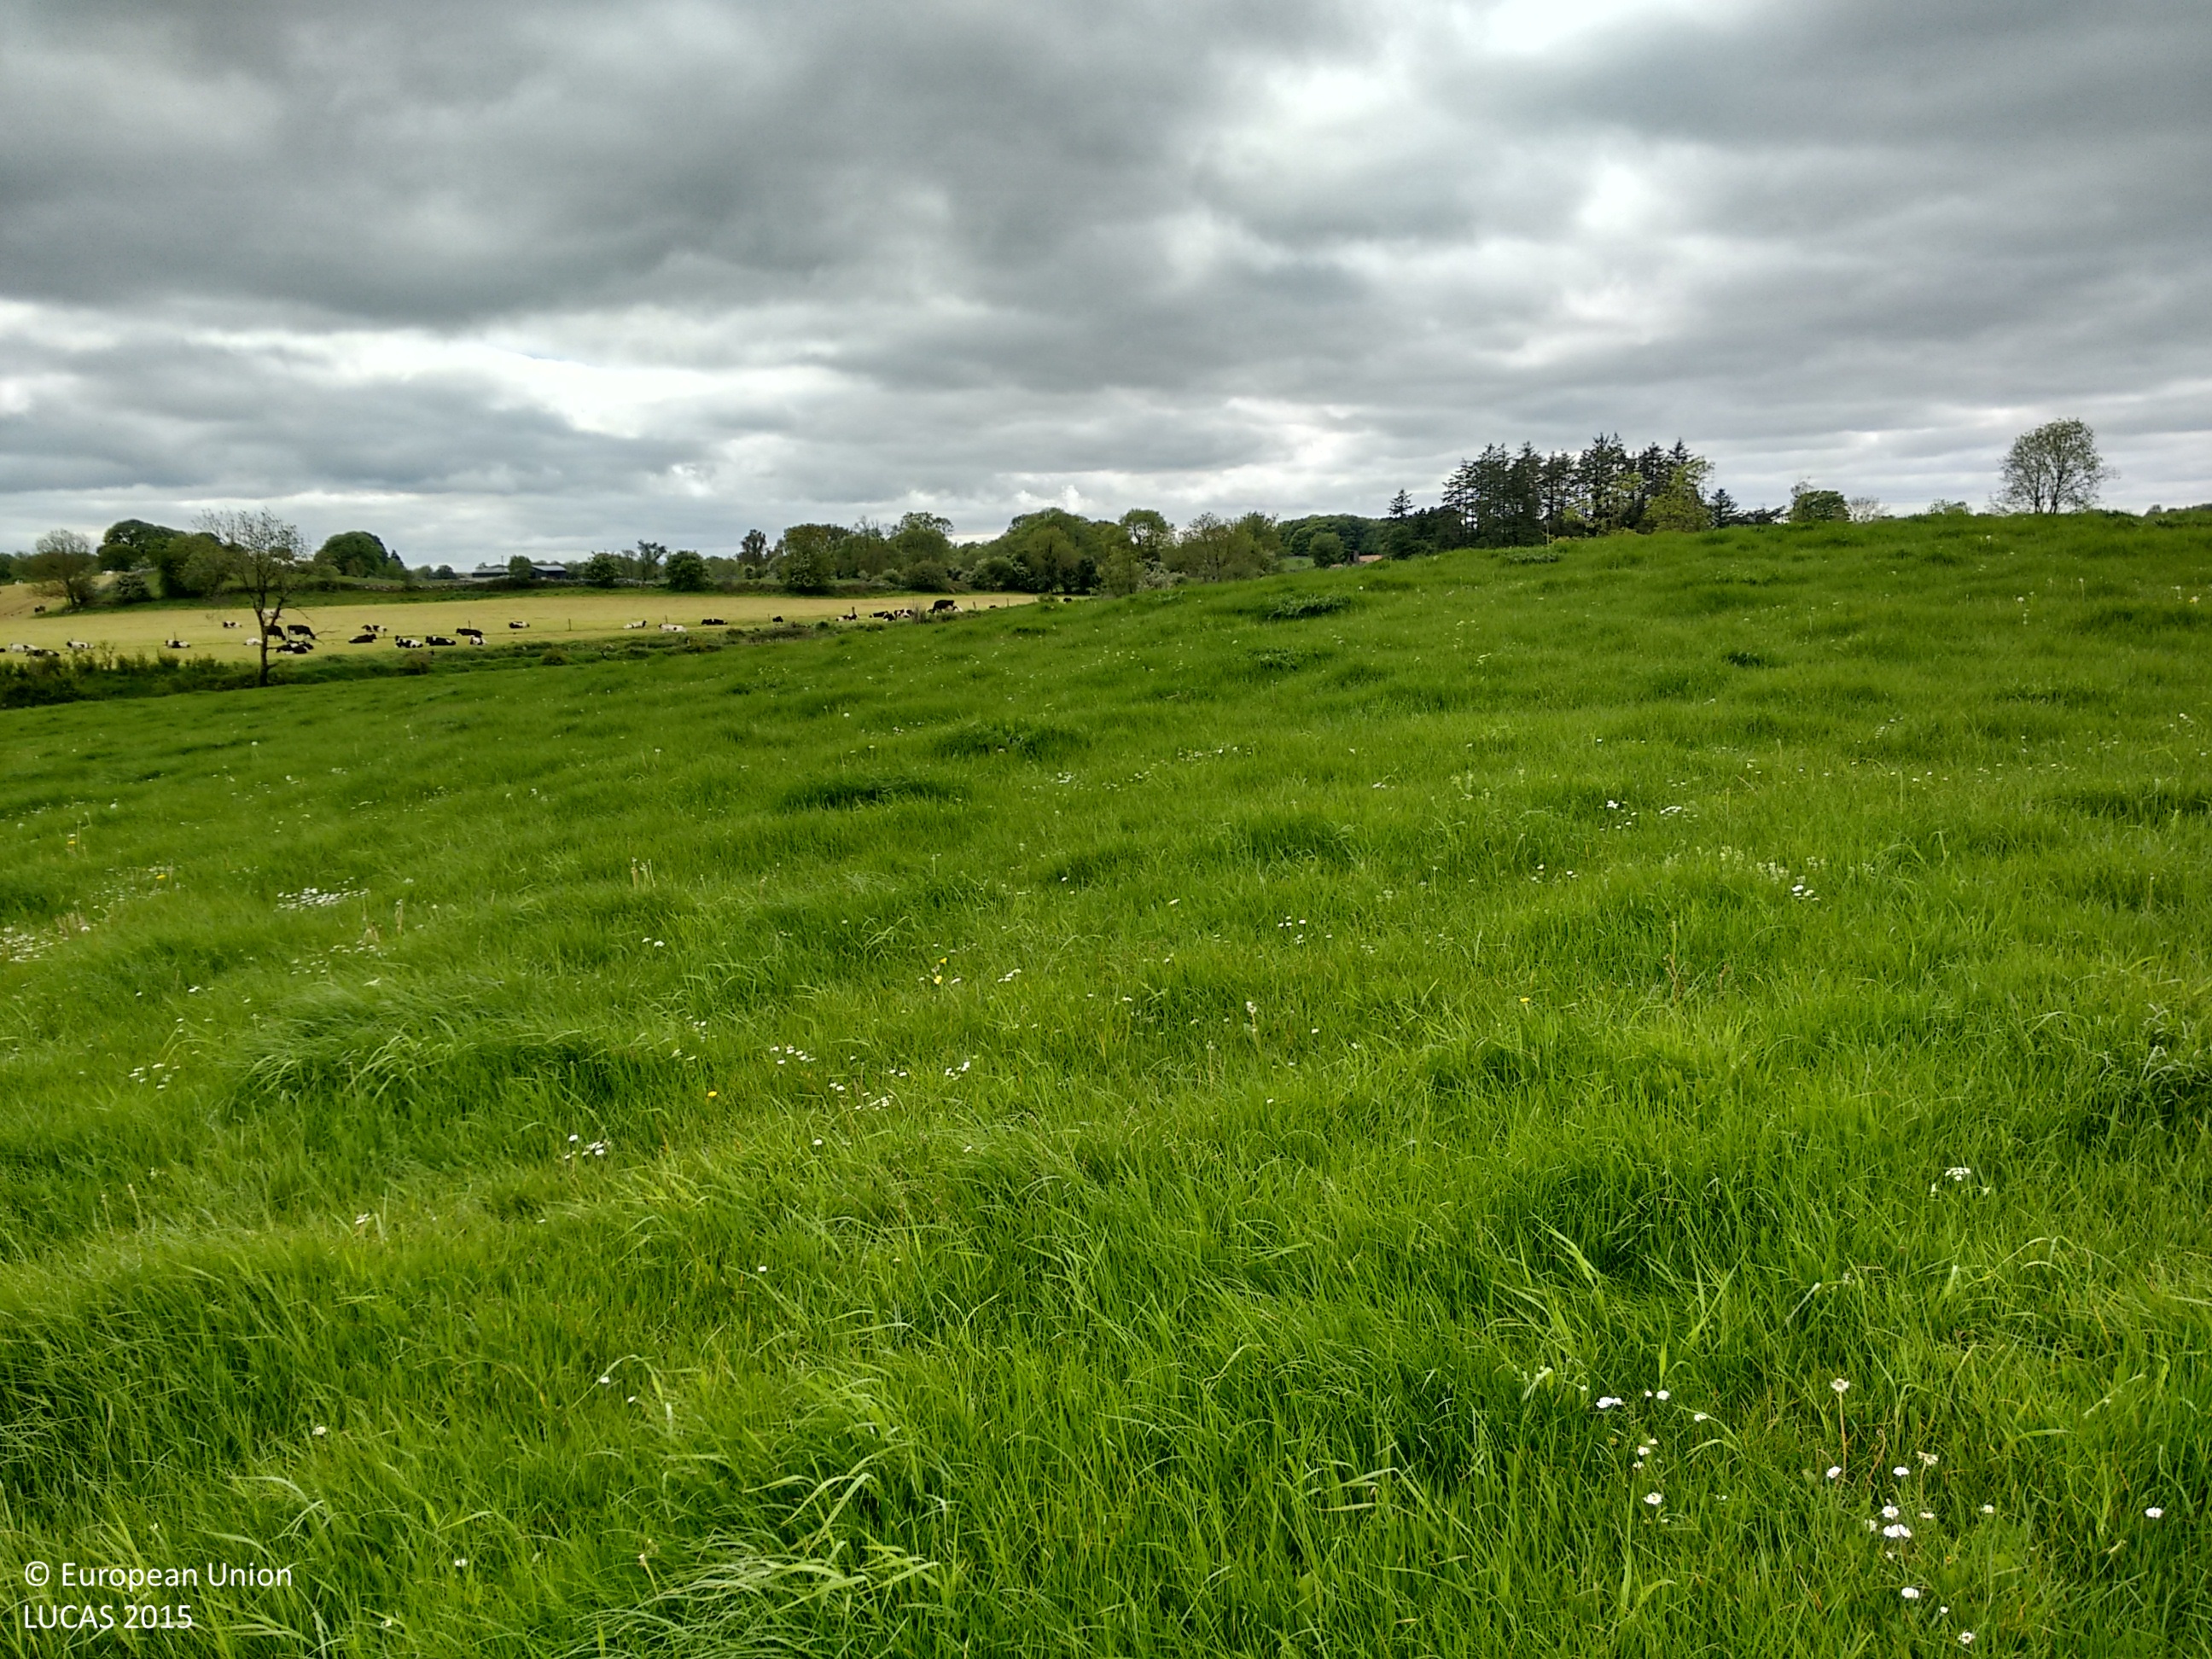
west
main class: Grassland
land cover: Grassland without tree/shrub cover
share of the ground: > 75 %
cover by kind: herbaceous plants 100 %
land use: Agriculture (excluding fallow land and kitchen gardens)
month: May
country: IE
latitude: 53.2594
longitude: -8.6839
